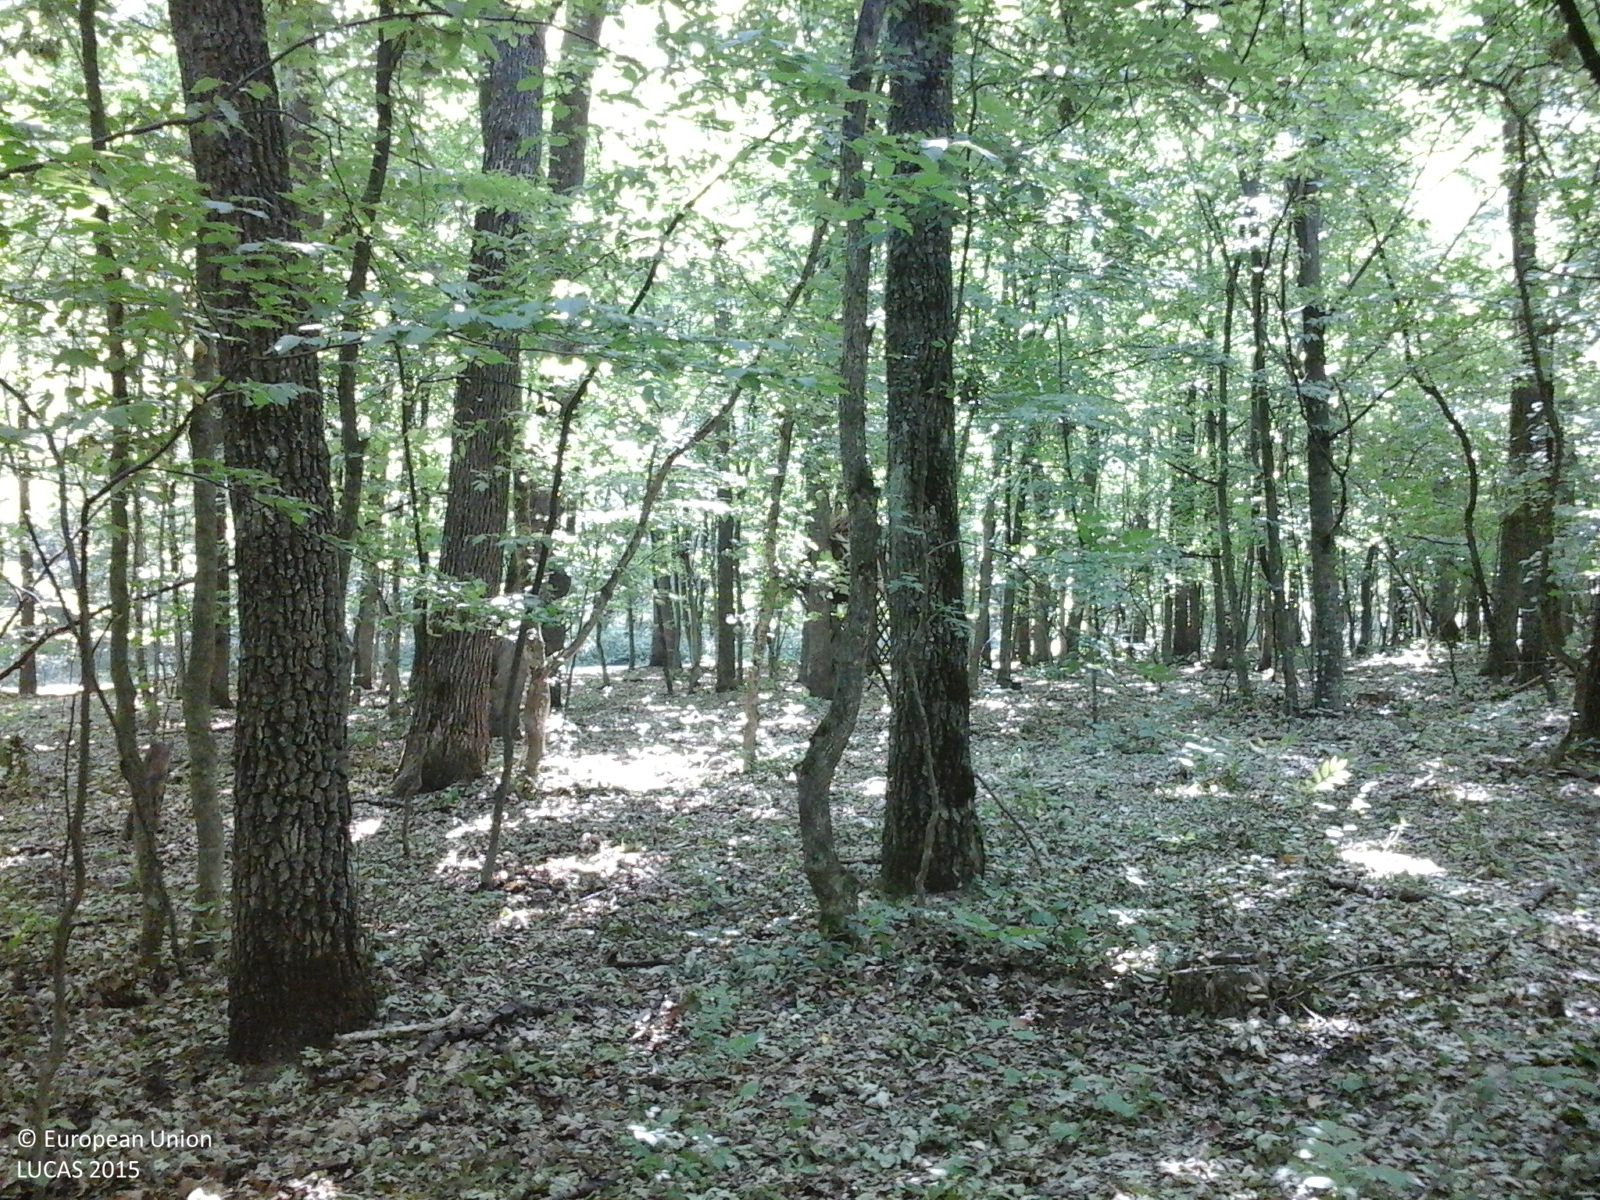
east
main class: Woodland
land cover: Broadleaved woodland
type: mesophytic deciduous forest
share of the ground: > 75 %
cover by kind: broadleaved forest trees 95 %, herbaceous plants 5 %
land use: Forestry
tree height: > 5 m
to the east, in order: Broadleaved woodland; Tracks; Broadleaved woodland; Tracks; Broadleaved woodland
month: June
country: RO
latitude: 46.8794
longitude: 27.9606
